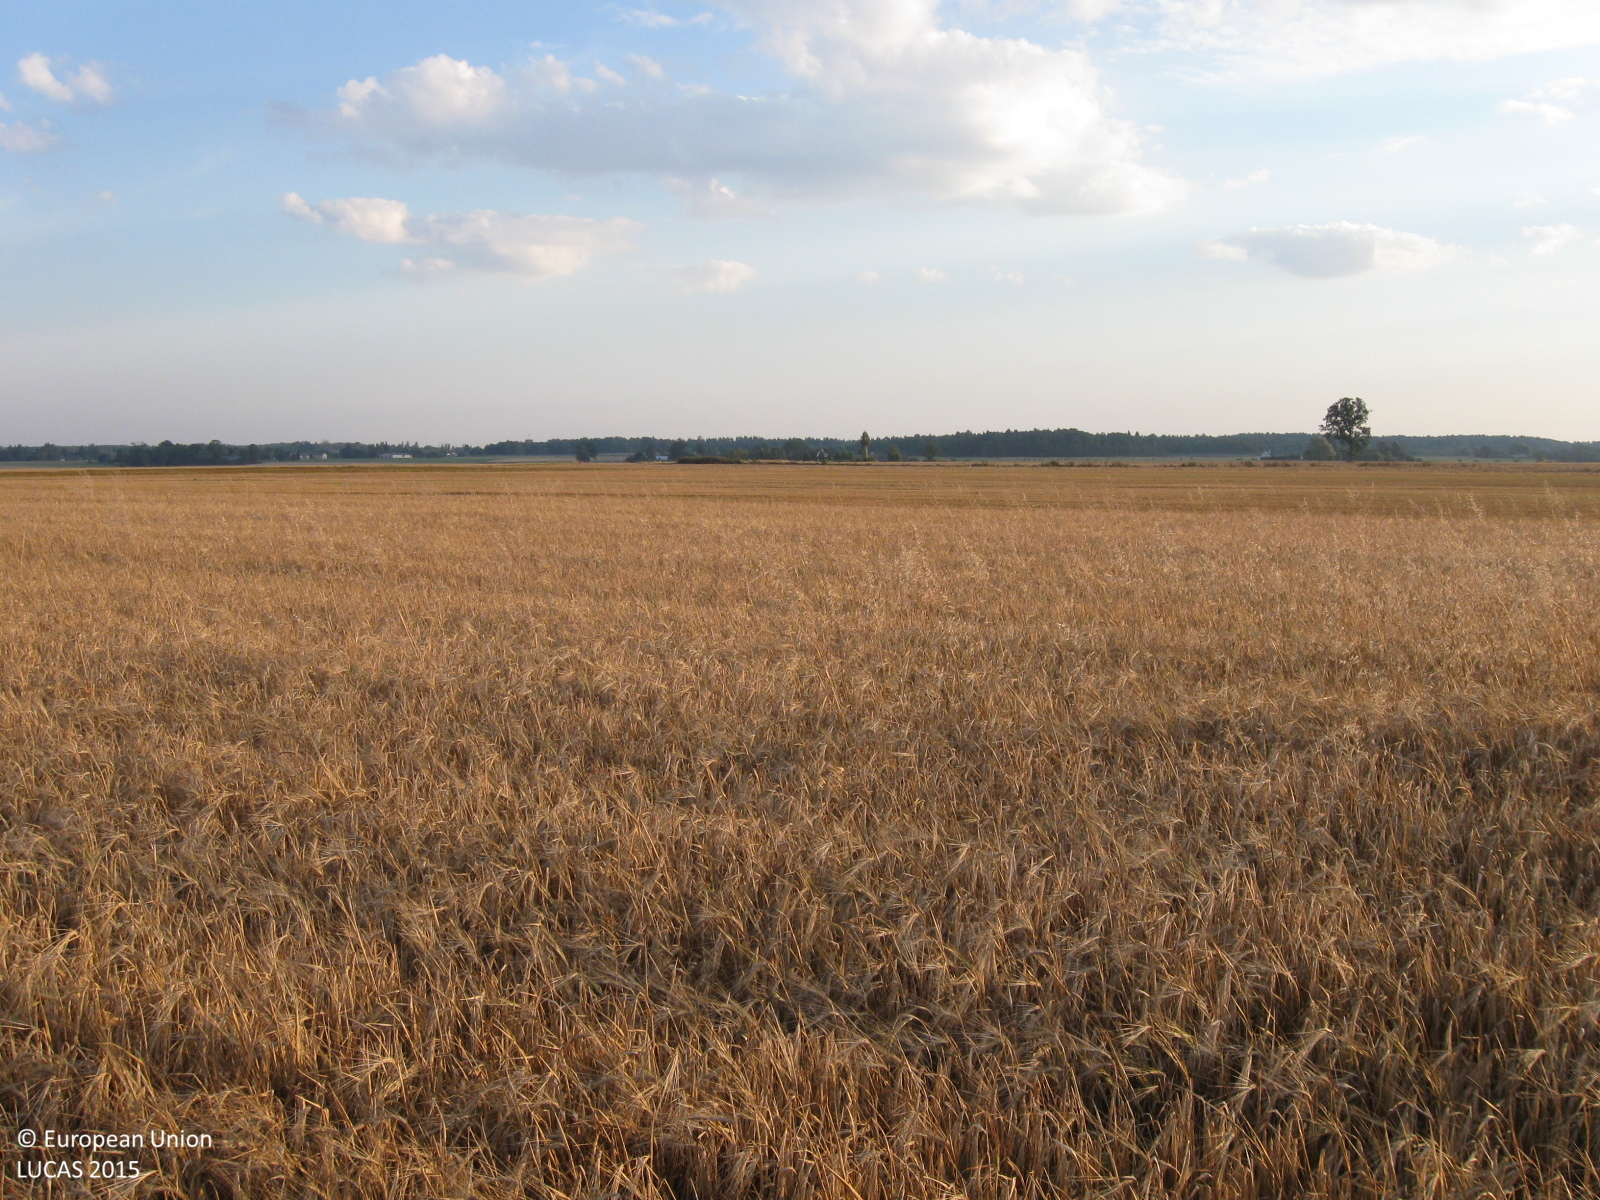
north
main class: Cropland
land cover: Barley
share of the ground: > 75 %
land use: Agriculture (excluding fallow land and kitchen gardens)
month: August
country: LT
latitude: 55.3694
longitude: 22.8961
